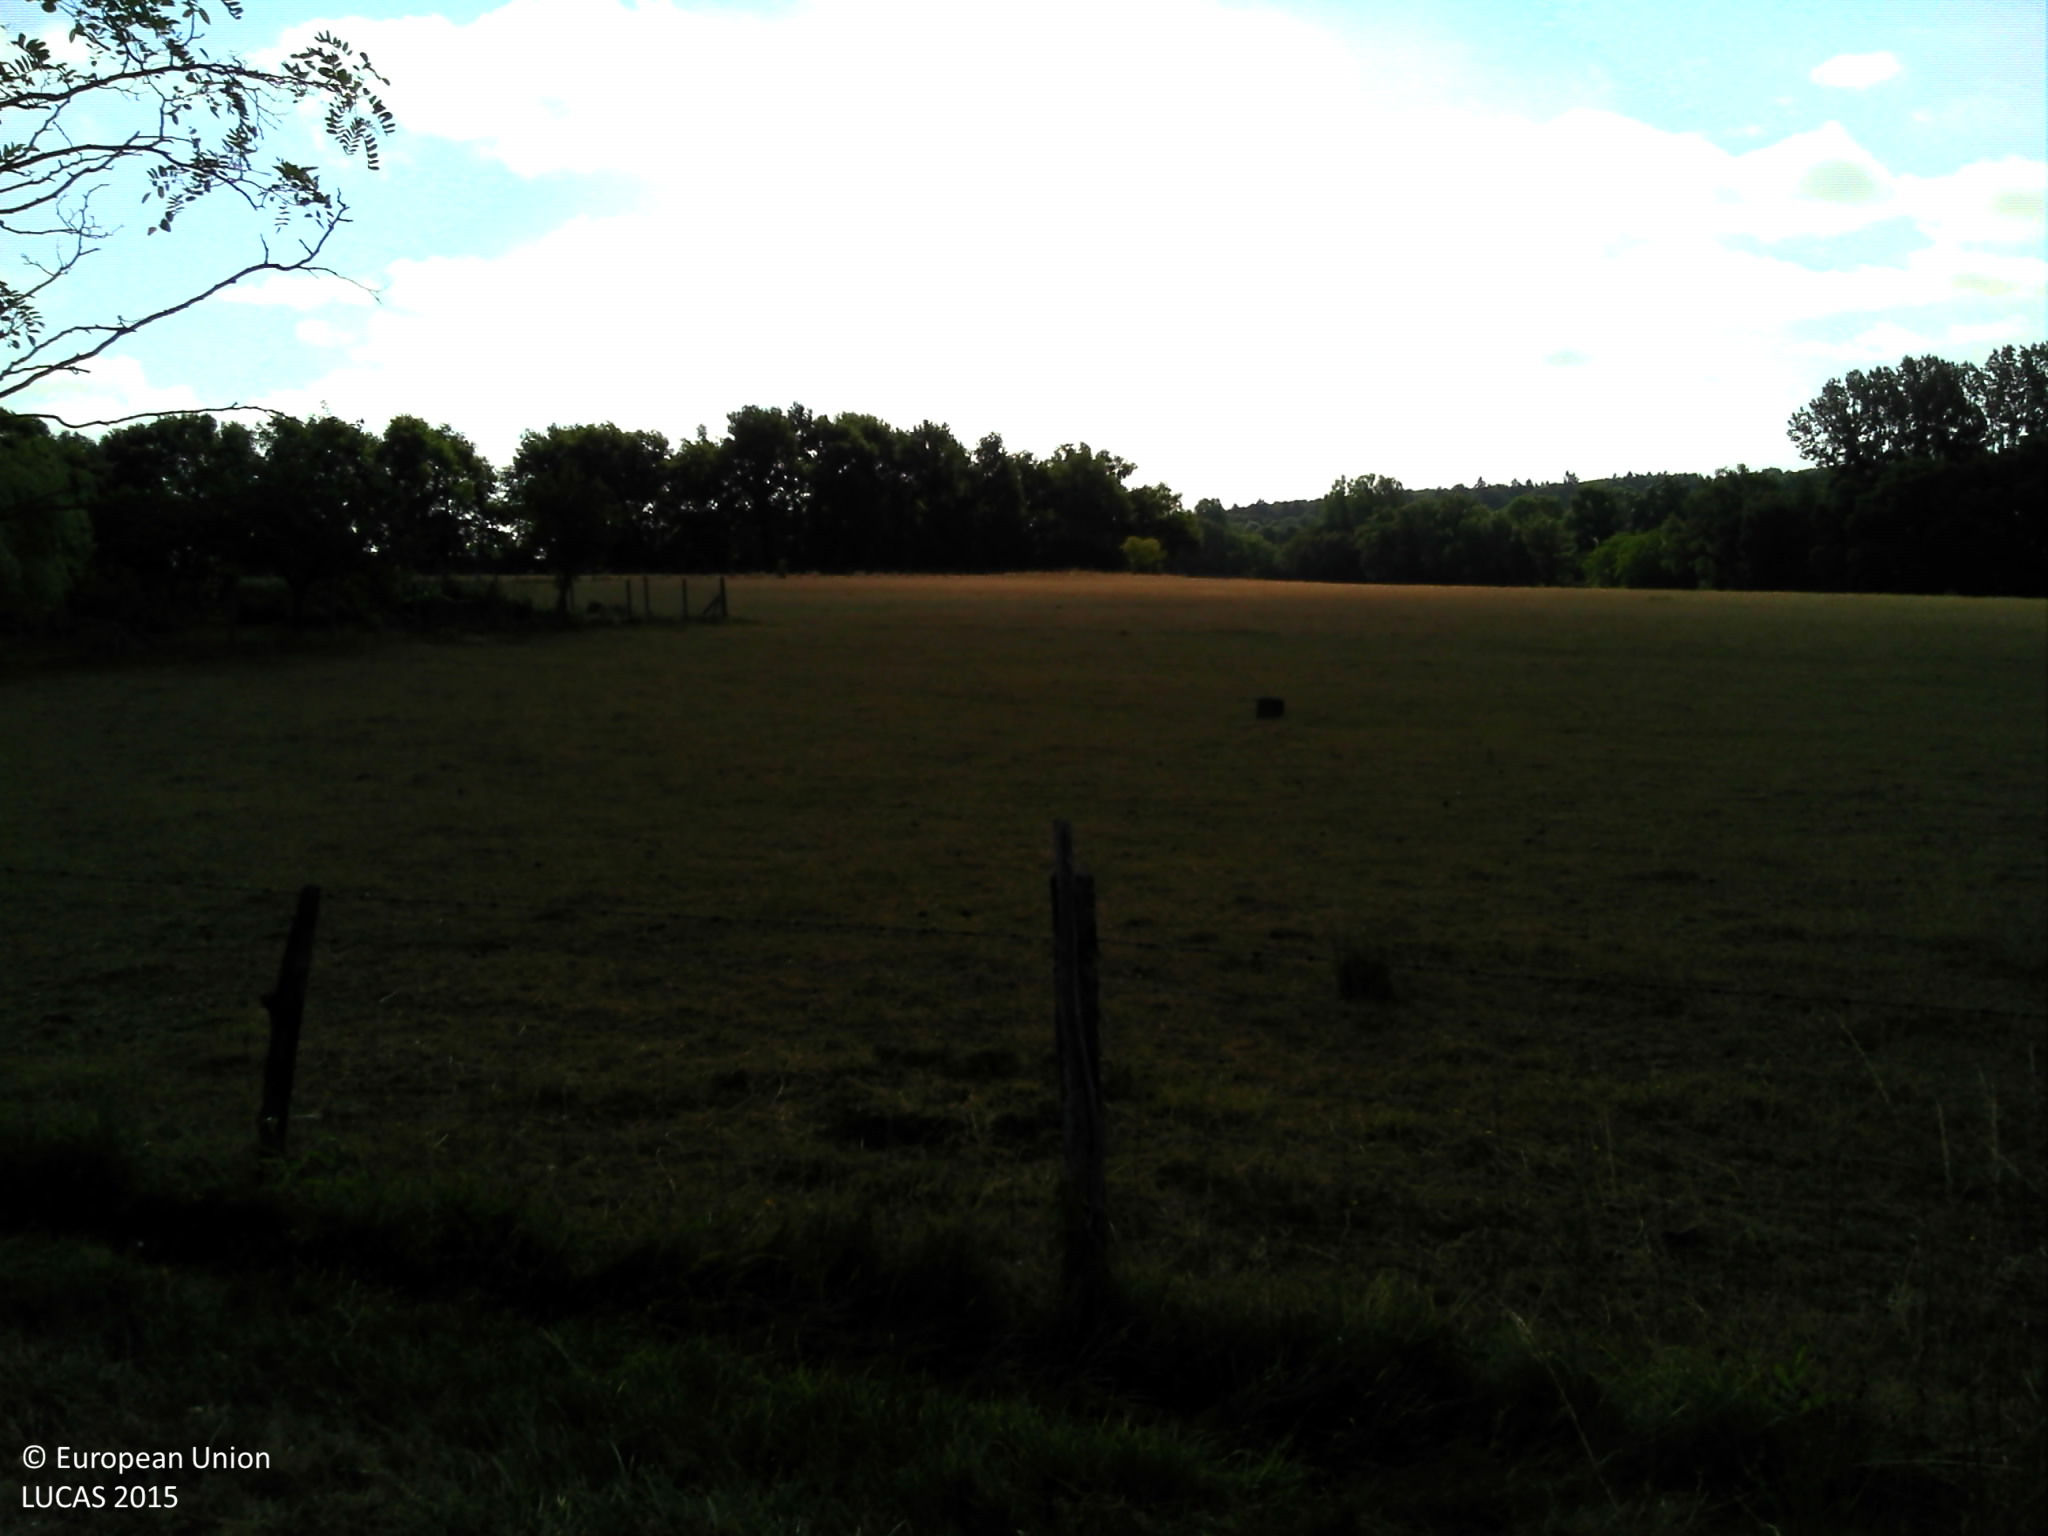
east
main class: Grassland
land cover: Grassland without tree/shrub cover
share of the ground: > 75 %
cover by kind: herbaceous plants 100 %
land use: Agriculture (excluding fallow land and kitchen gardens)
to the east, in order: Grassland without tree/shrub cover; Managed hedges; Grassland without tree/shrub cover; Grassland with sparse tree/shrub cover; Artificial constructions in urban areas; Managed hedges; Grassland without tree/shrub cover
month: July
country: FR
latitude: 46.2183
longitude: 0.5075
